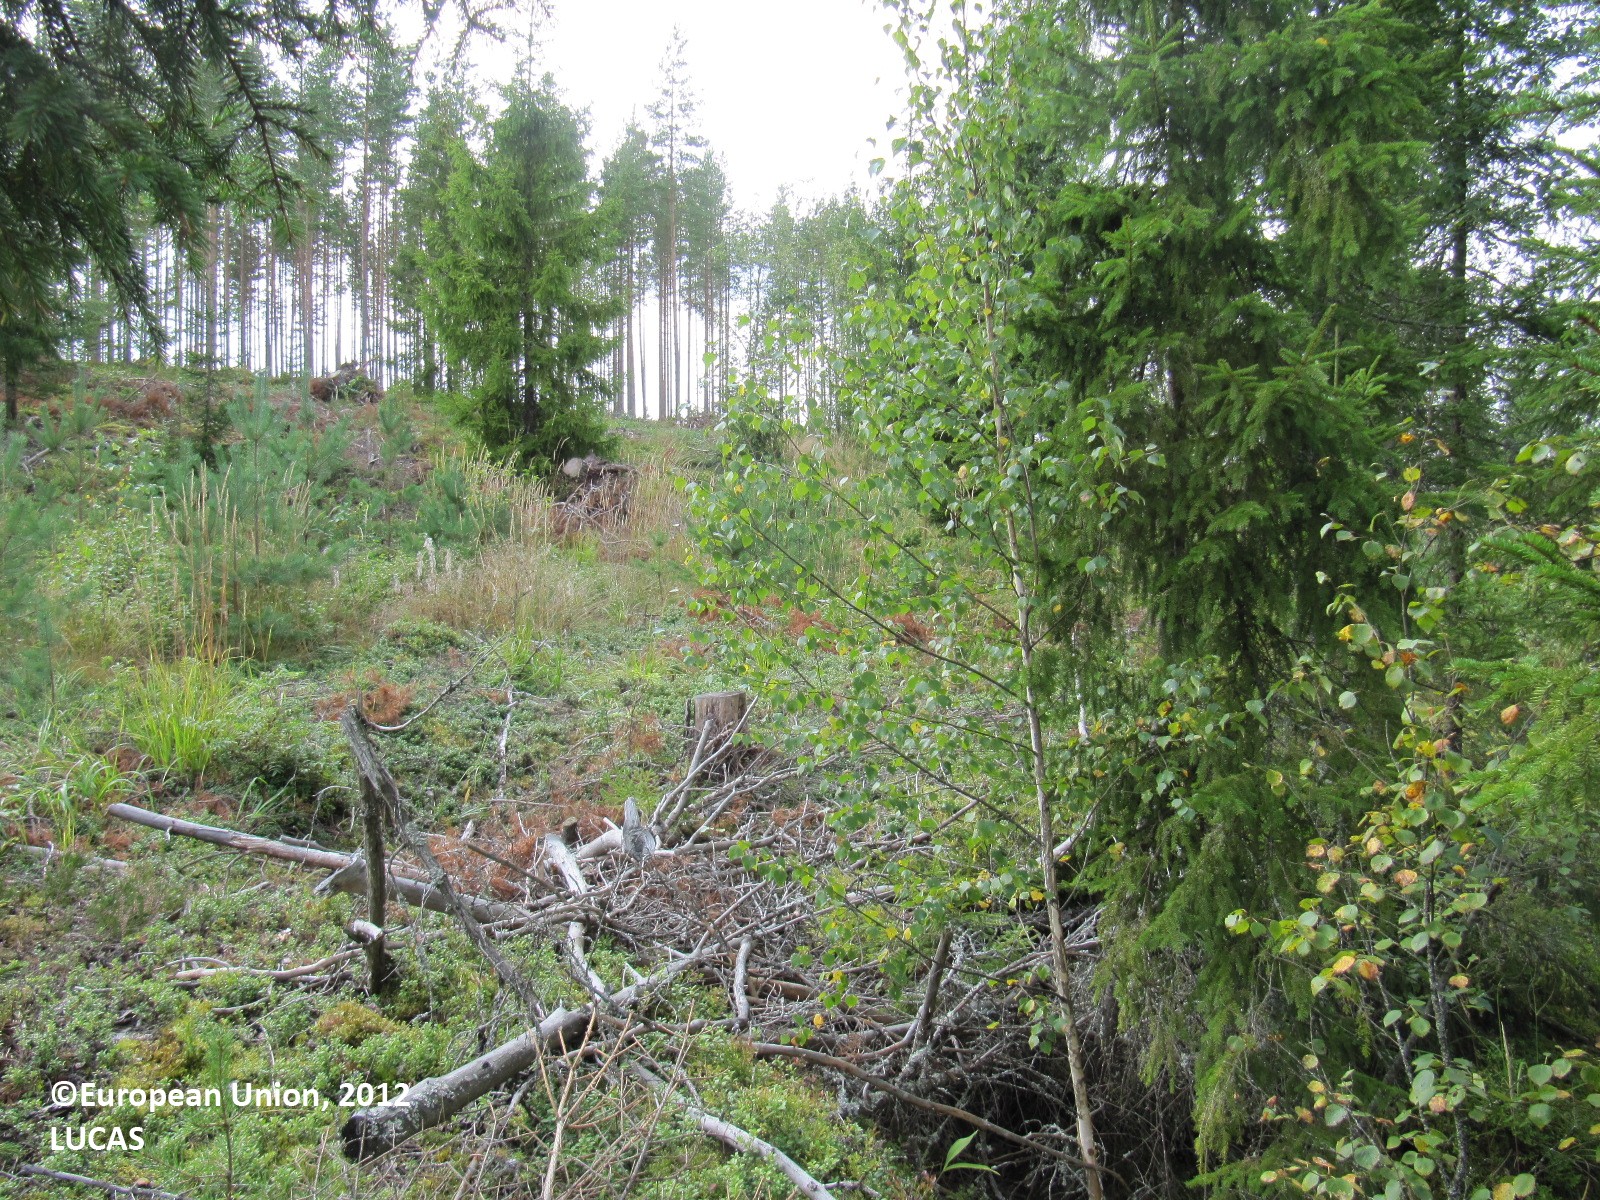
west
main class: Woodland
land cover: Spruce dominated mixed woodland
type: boreal forest
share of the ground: 50 - 75 %
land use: Forestry
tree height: > 5 m
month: August
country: FI
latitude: 61.1036
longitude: 22.8911
